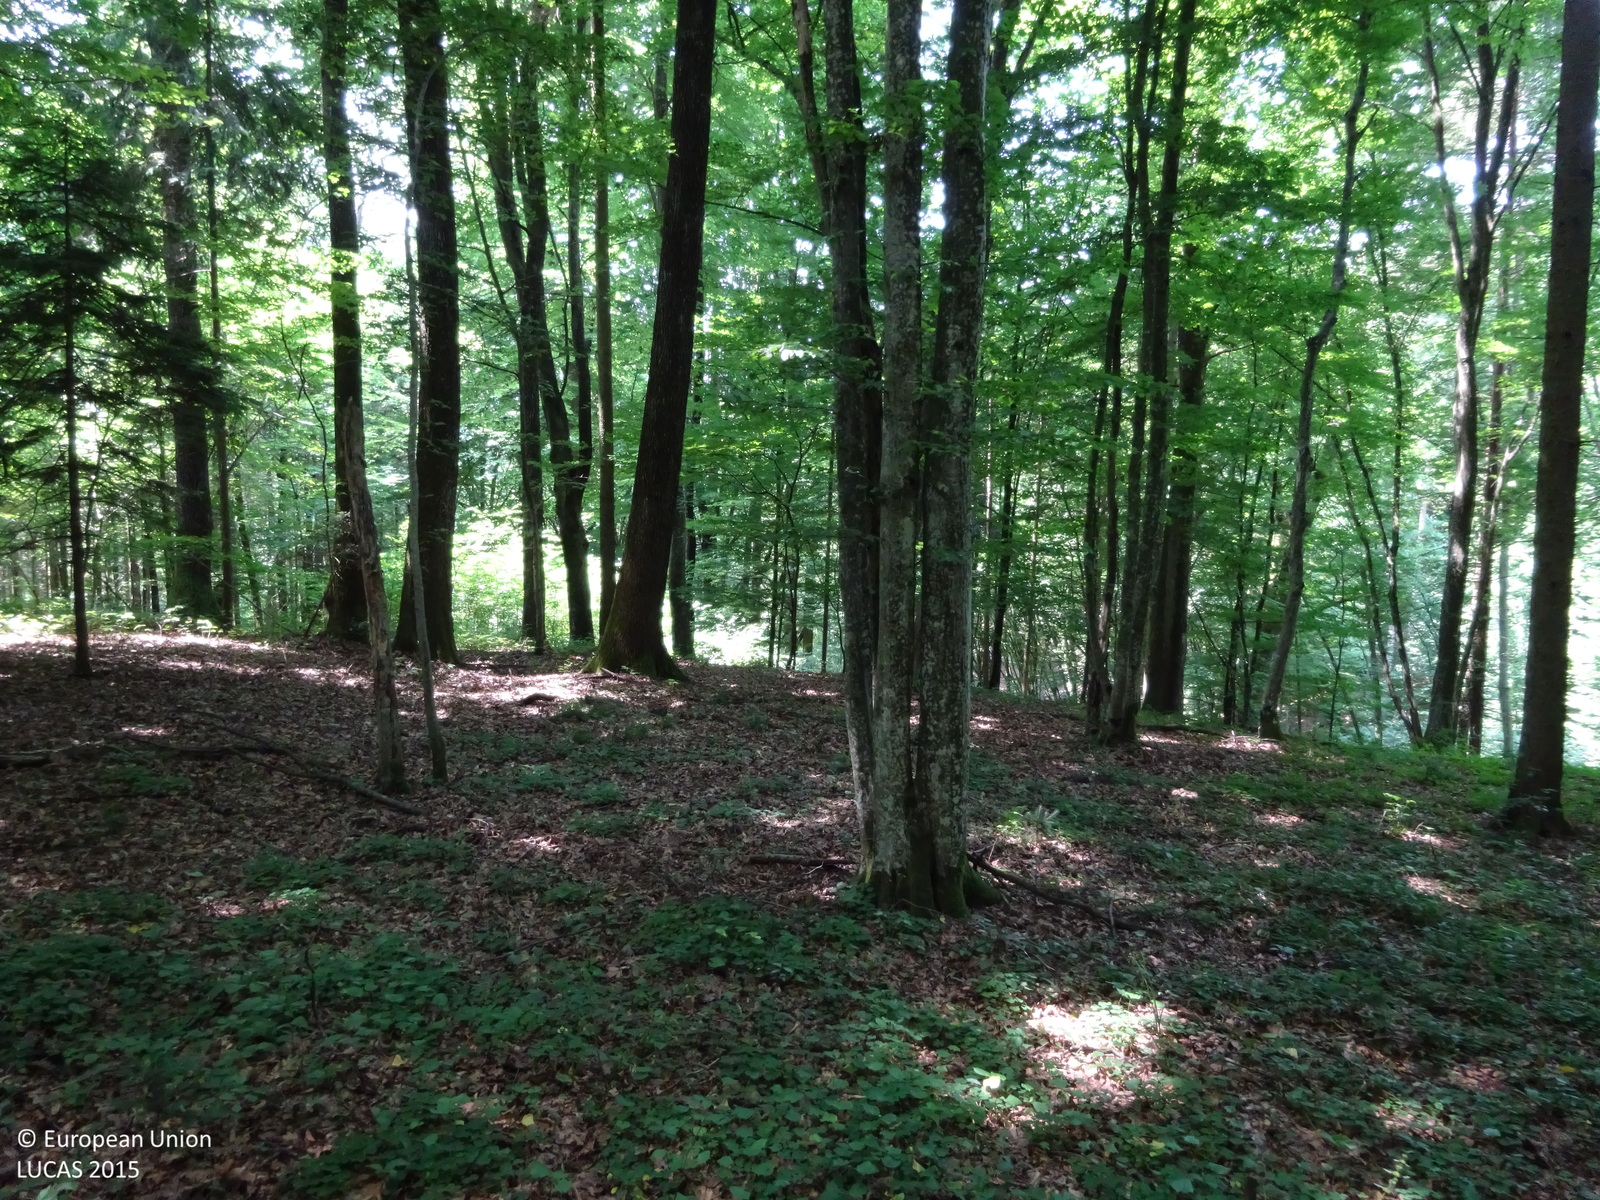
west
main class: Woodland
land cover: Broadleaved woodland
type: mountainous beech forest
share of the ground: > 75 %
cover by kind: broadleaved forest trees 100 %
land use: Forestry
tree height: > 5 m
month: June
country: AT
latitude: 46.8497
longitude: 16.0202
